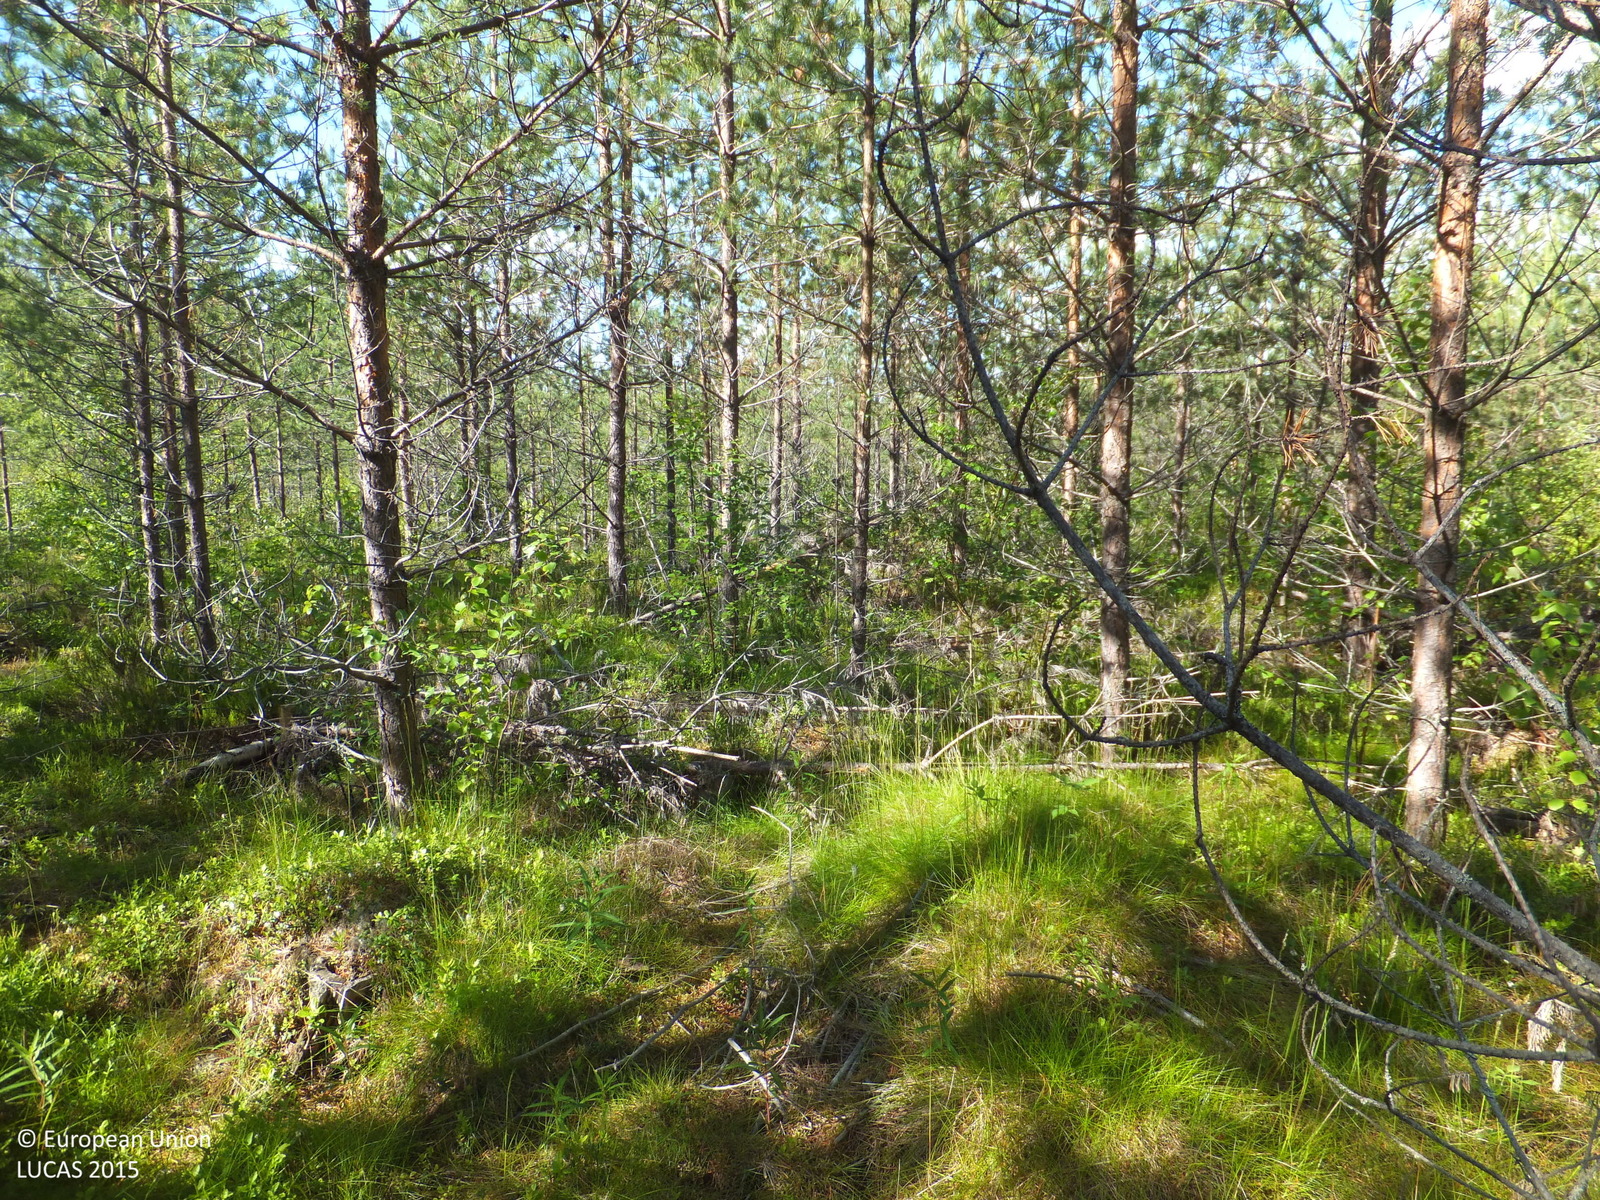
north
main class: Woodland
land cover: Pine dominated coniferous woodland
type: boreal forest
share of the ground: > 75 %
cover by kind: coniferous forest trees 80 %, shrubs 10 %, broadleaved forest trees 5 %, herbaceous plants 5 %
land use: Forestry
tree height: < 5 m
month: July
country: FI
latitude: 63.0862
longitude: 23.8743
